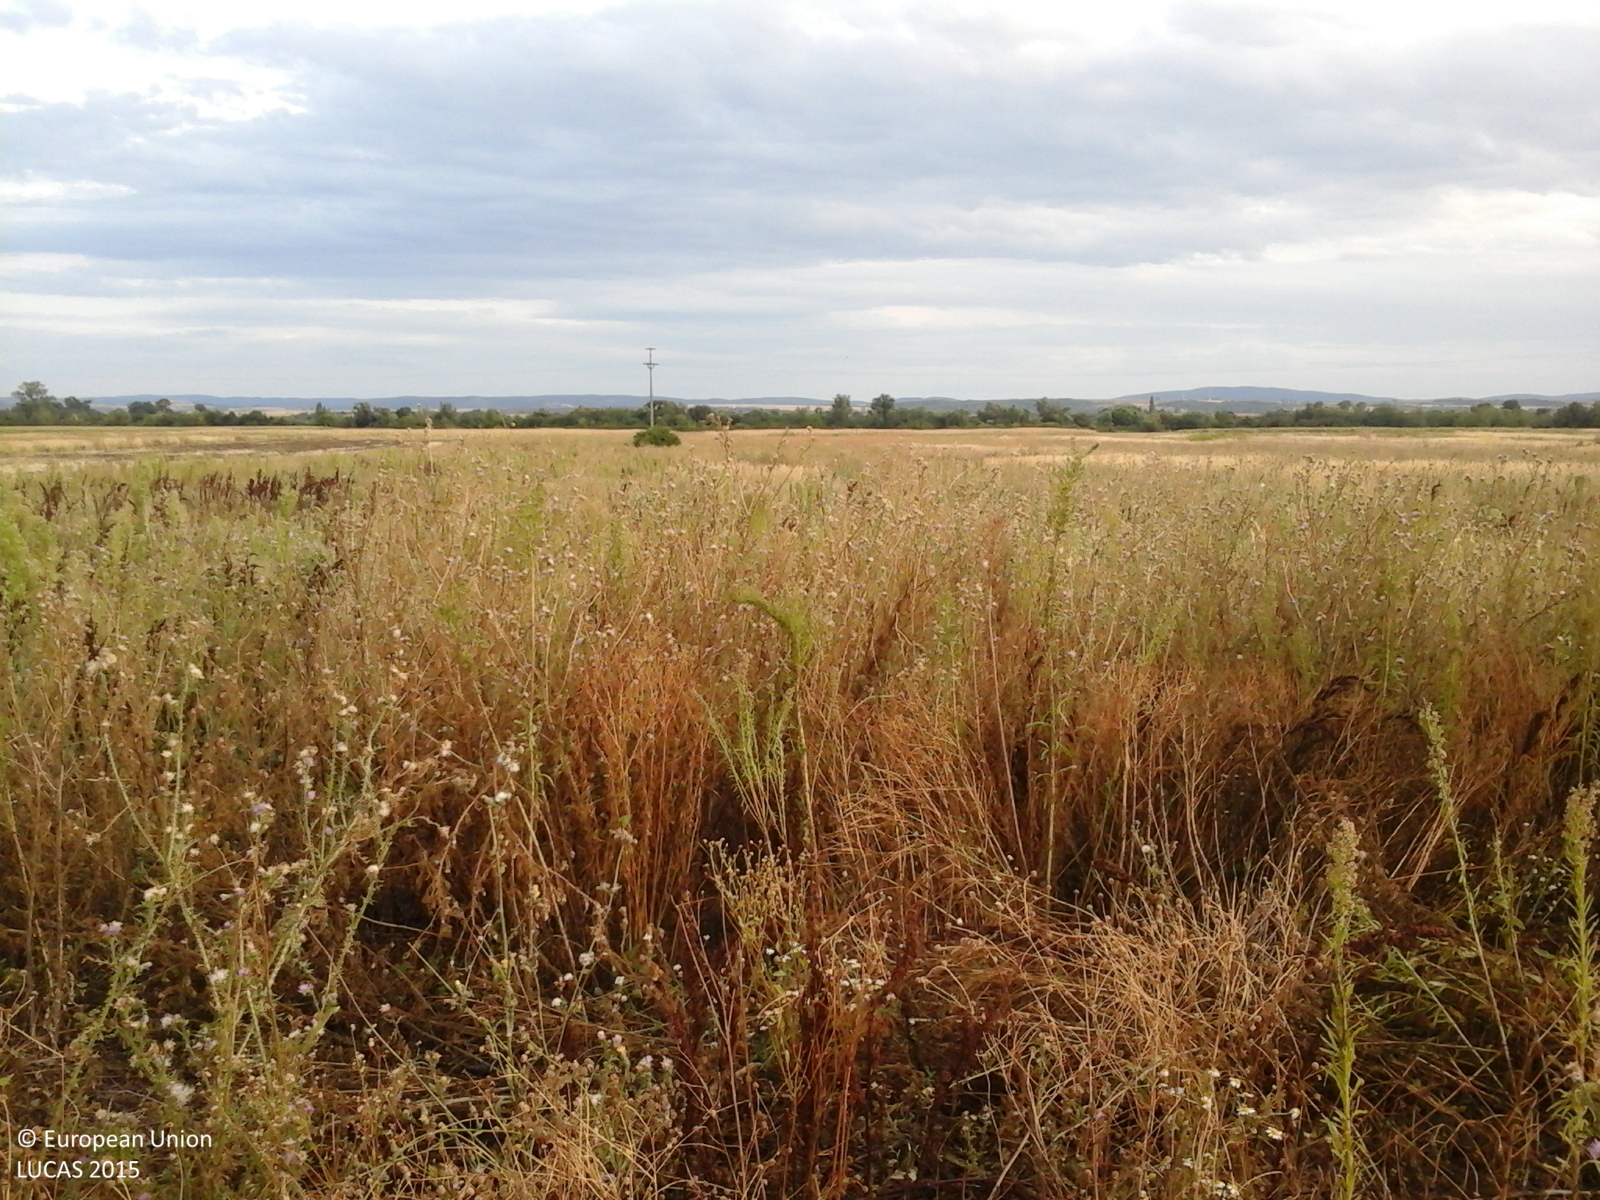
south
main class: Grassland
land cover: Spontaneously vegetated surfaces
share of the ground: > 75 %
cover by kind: herbaceous plants 100 %
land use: Fallow land
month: August
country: RO
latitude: 44.9917
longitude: 21.5853
